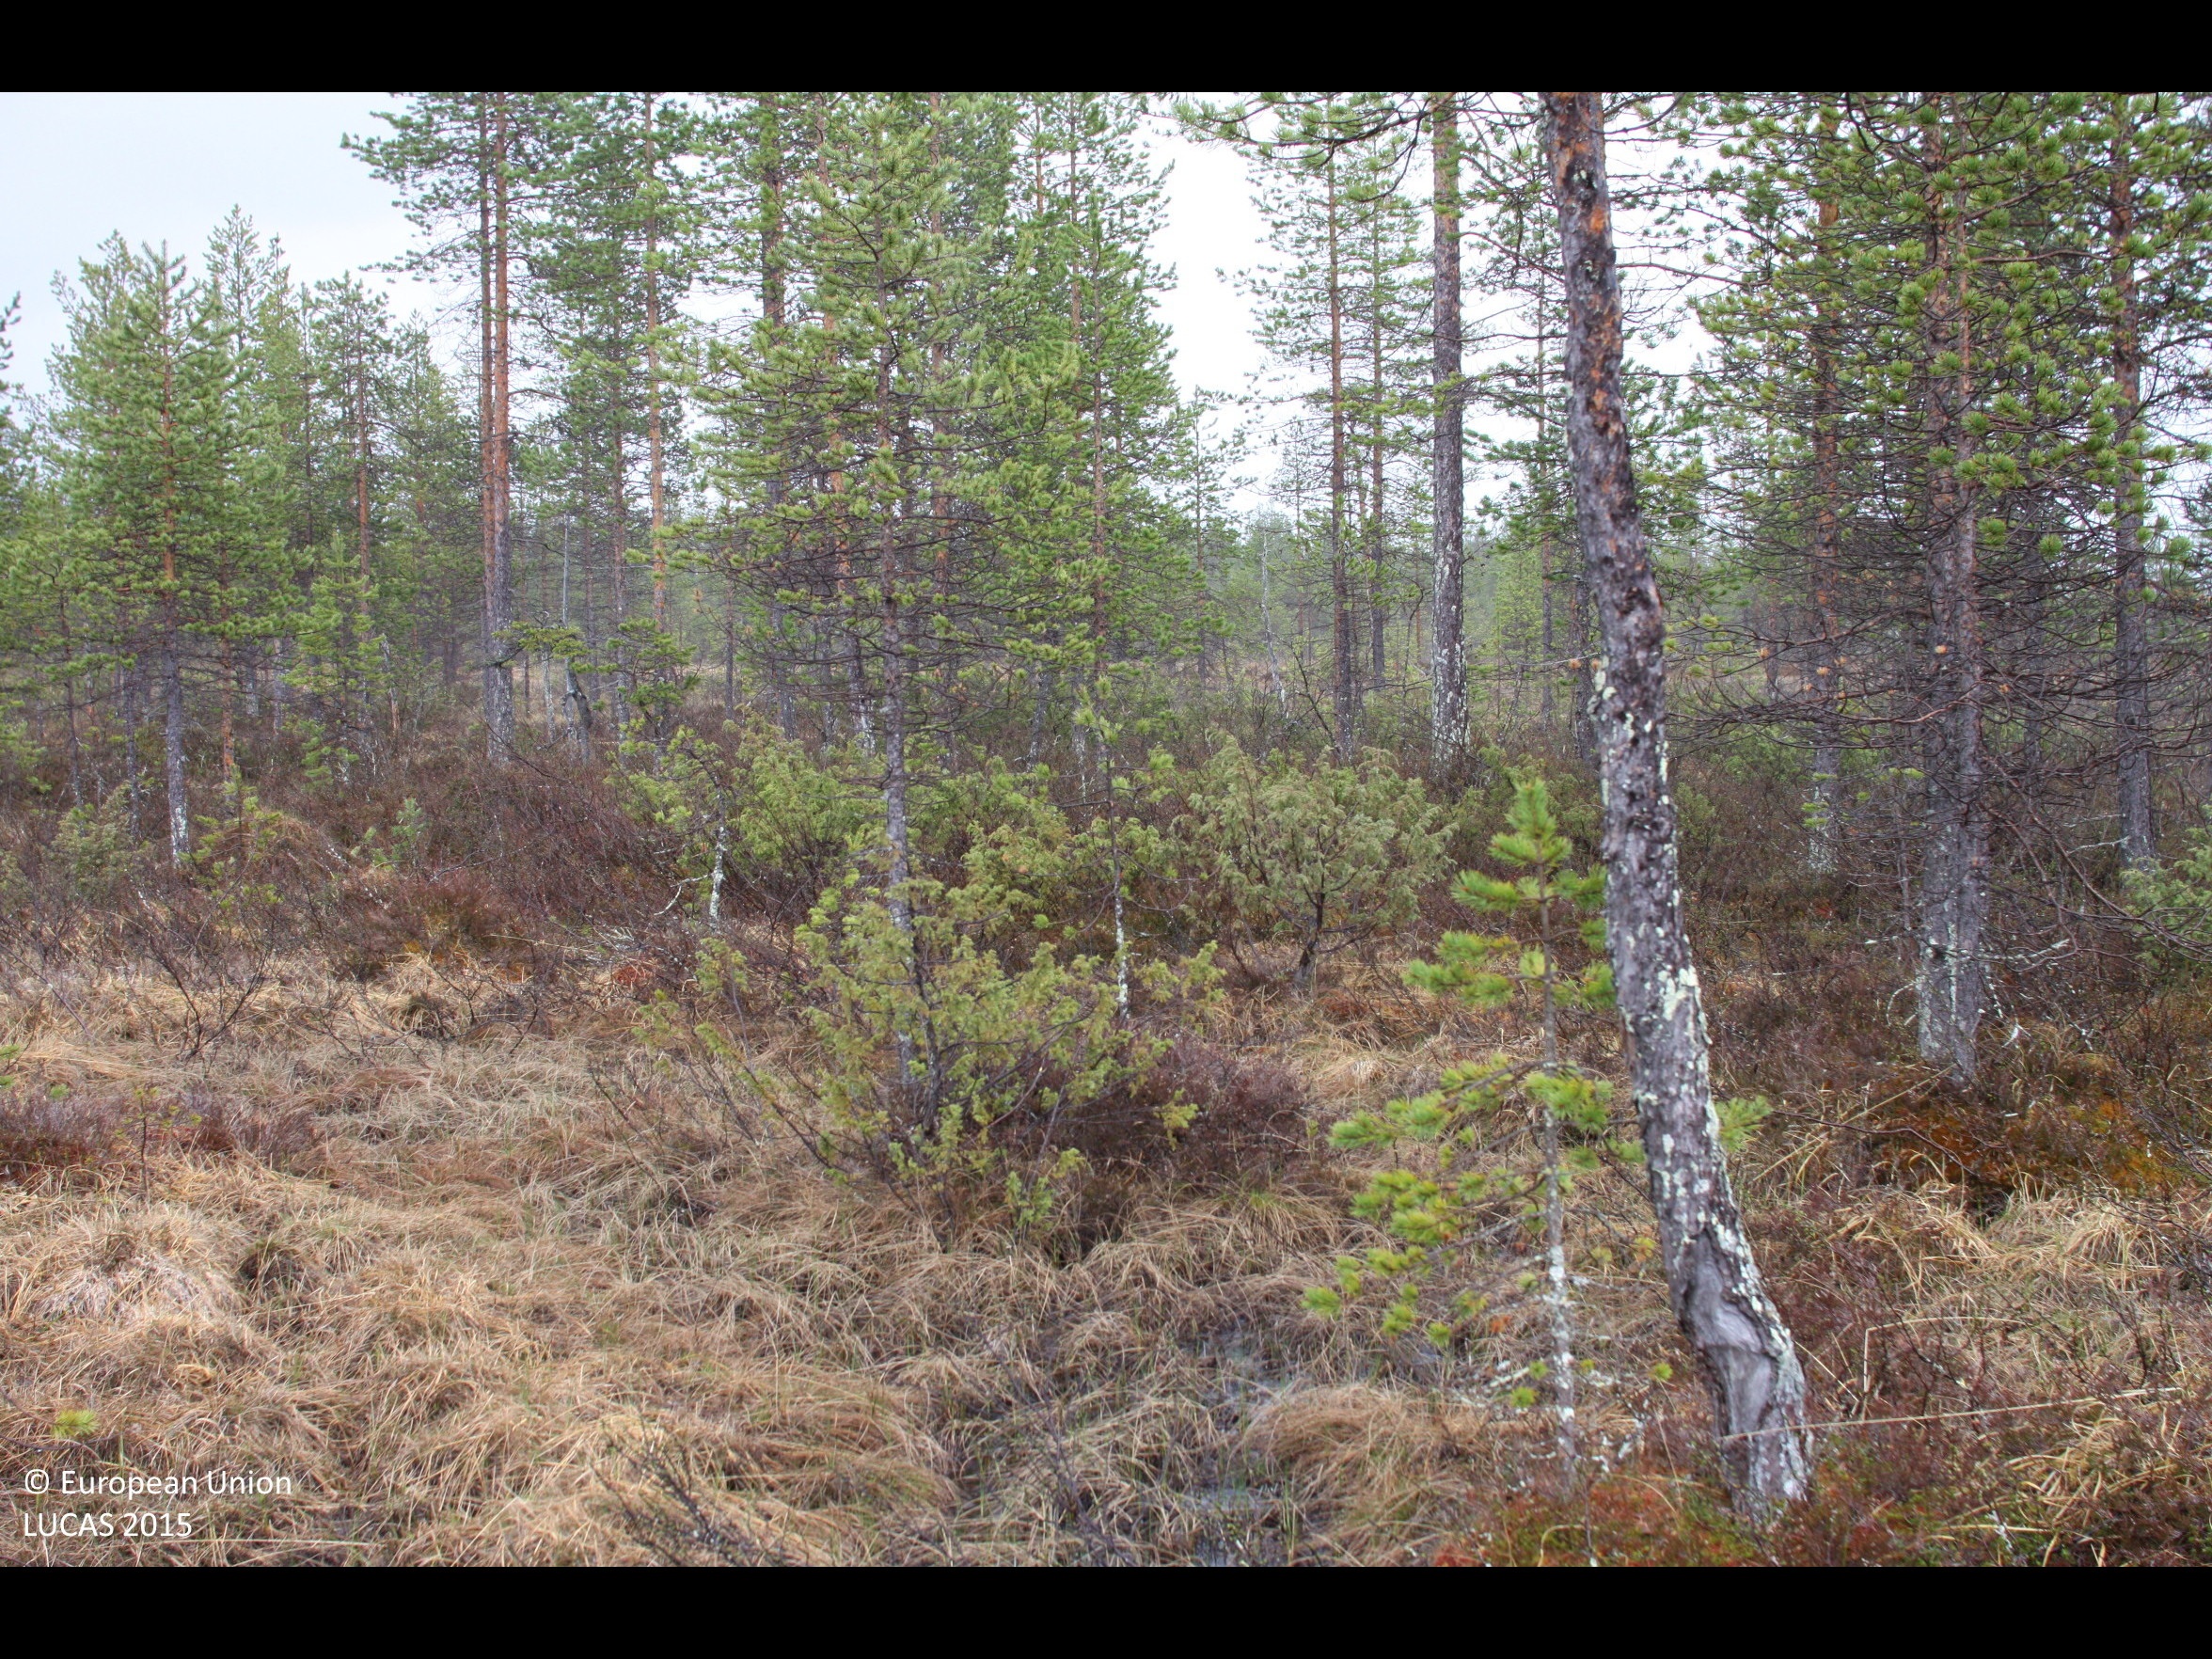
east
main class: Woodland
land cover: Pine dominated coniferous woodland
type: mire and swamp forests
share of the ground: 25 - 50 %
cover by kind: herbaceous plants 30 %, coniferous forest trees 25 %, lichens and mosses 25 %, shrubs 20 %
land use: Forestry
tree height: > 5 m
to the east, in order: Pine dominated coniferous woodland; Fences; Pine dominated coniferous woodland; Ditches and canals; Pine dominated coniferous woodland
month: June
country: FI
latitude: 66.2768
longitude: 28.2506
